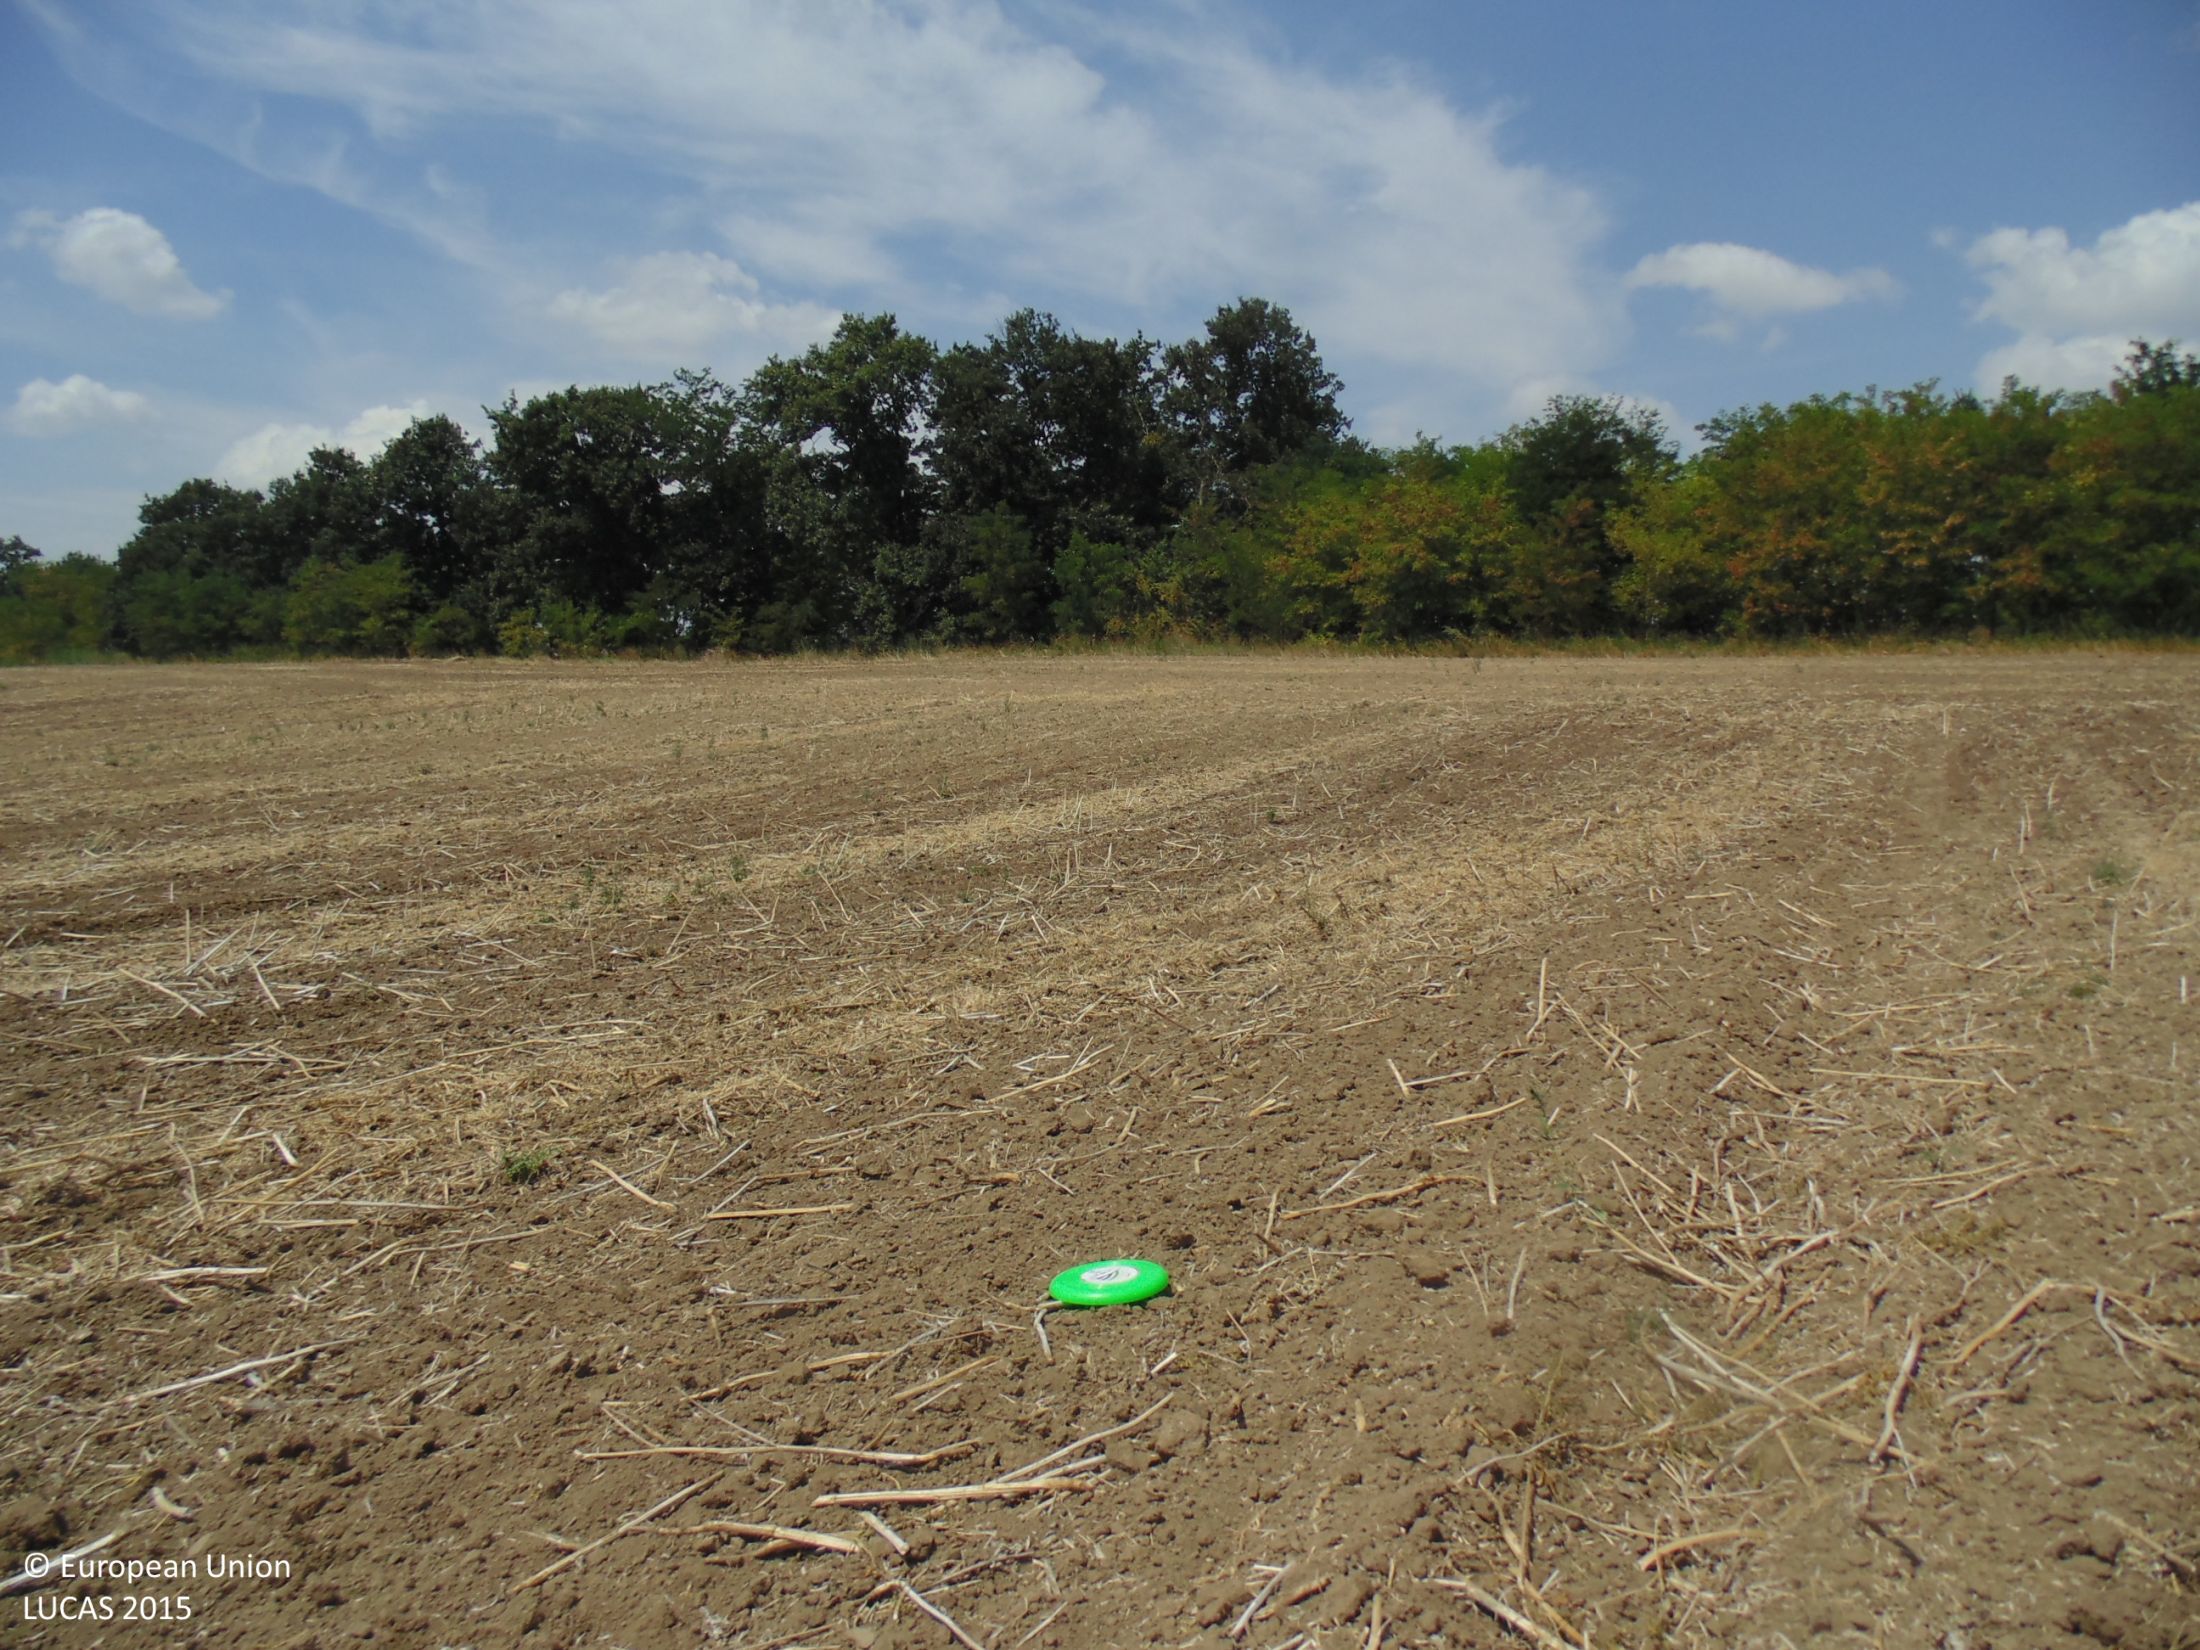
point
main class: Cropland
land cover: Rape and turnip rape
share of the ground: < 10 %
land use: Agriculture (excluding fallow land and kitchen gardens)
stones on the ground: < 10 %
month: August
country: BG
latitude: 43.9222
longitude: 27.7929
